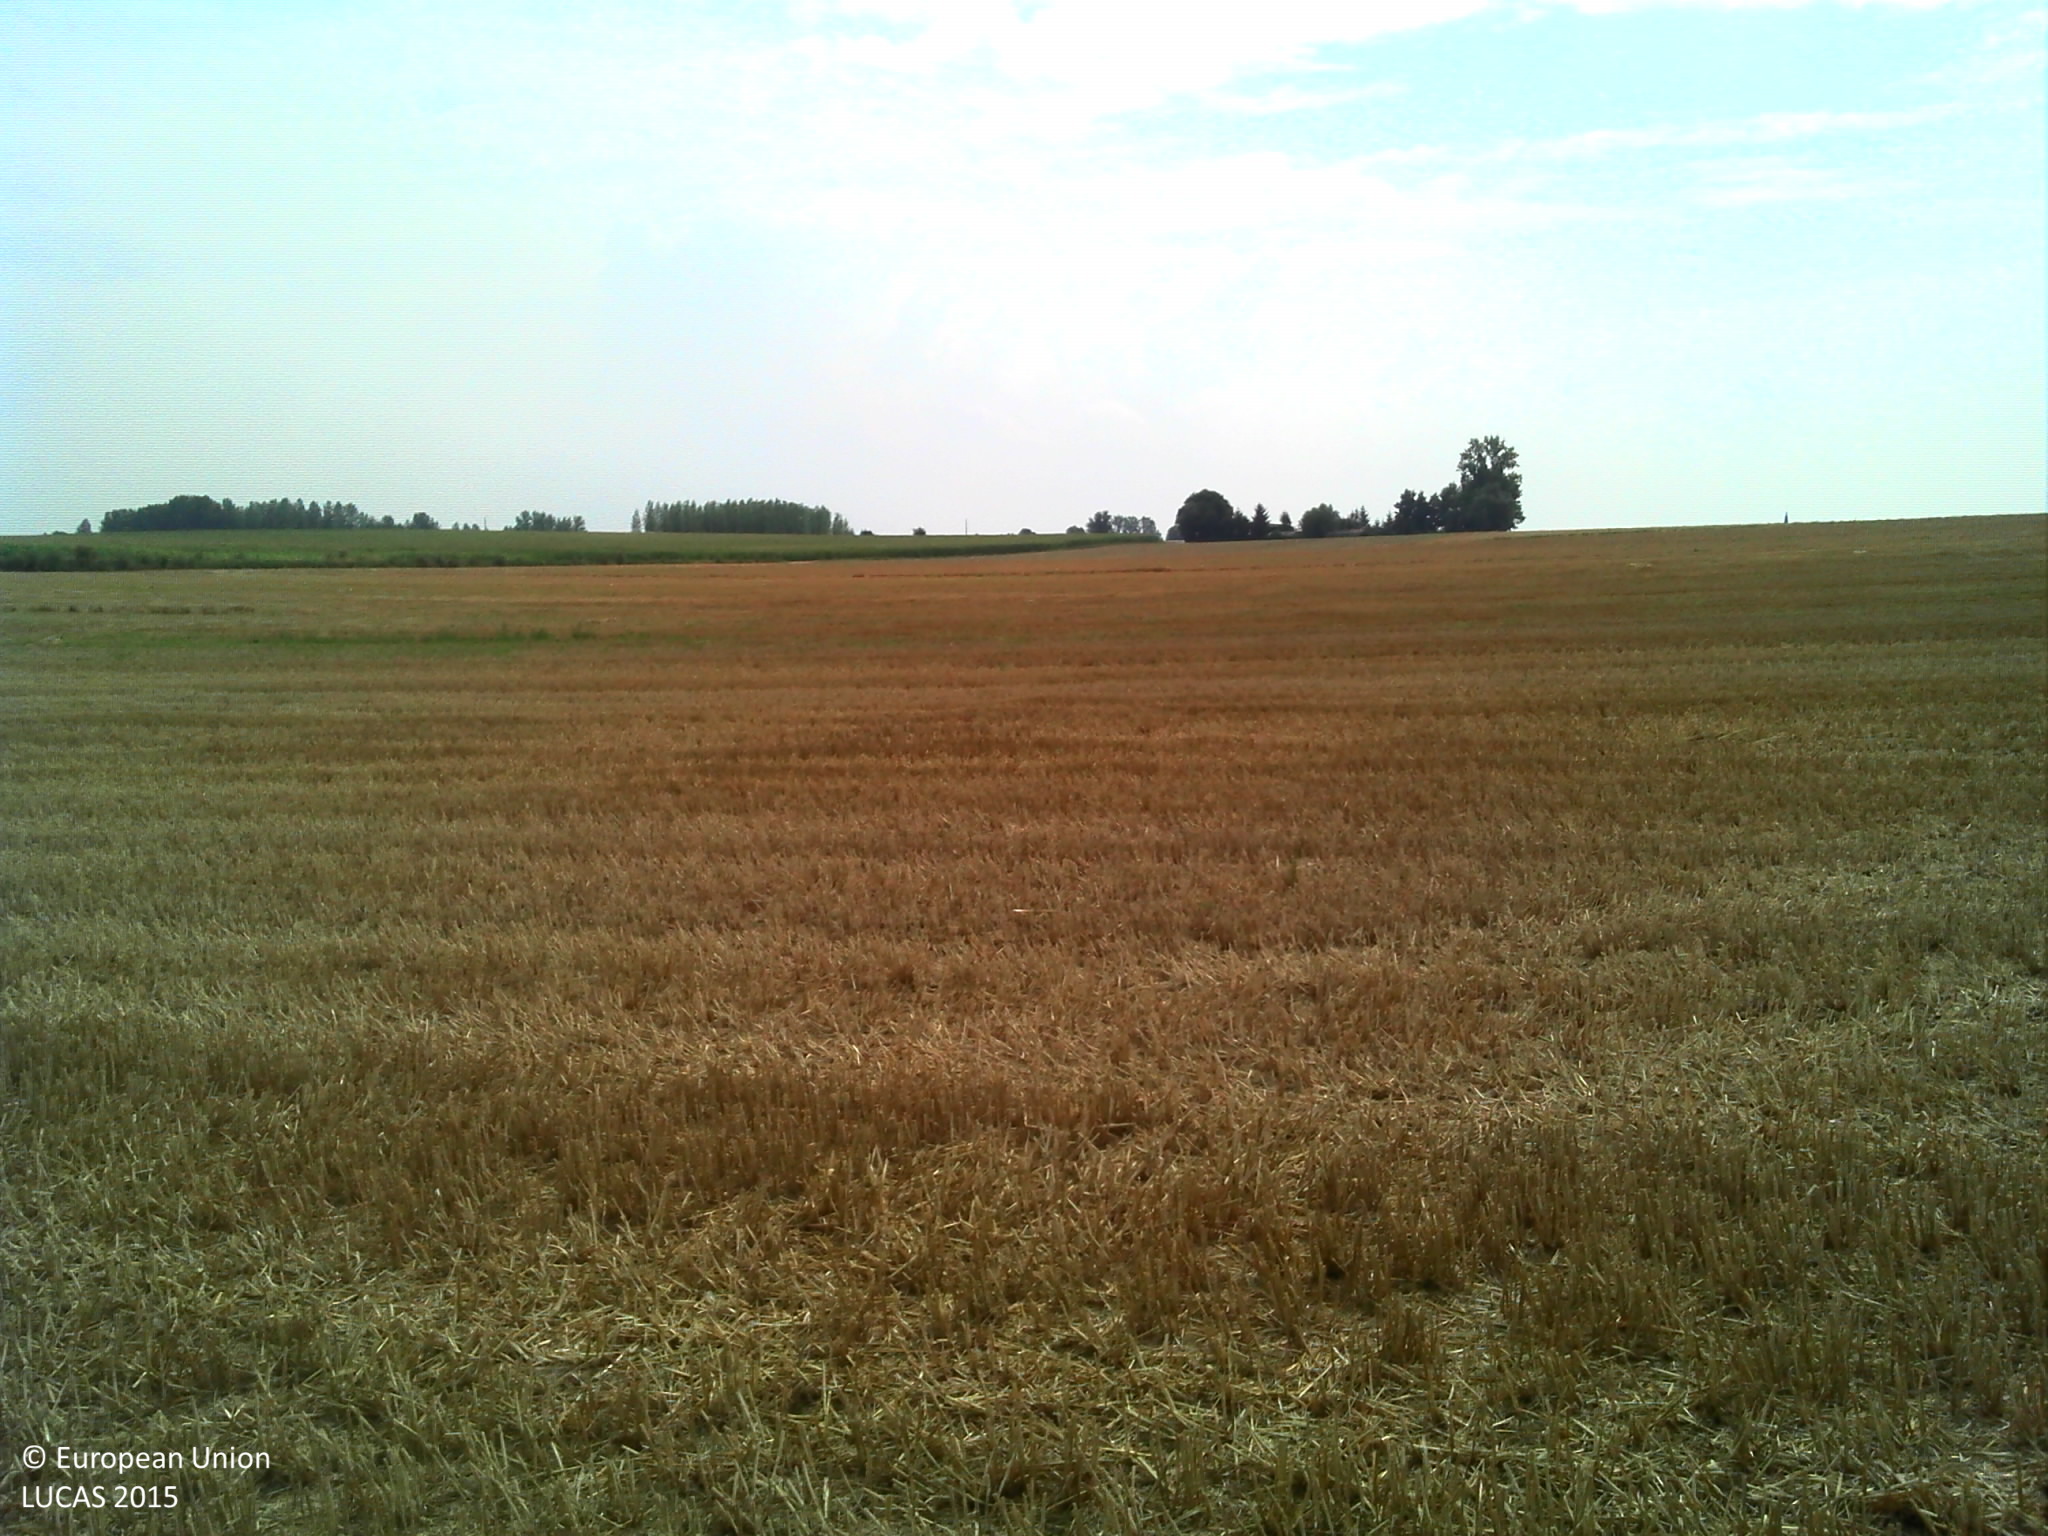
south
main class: Cropland
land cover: Common wheat
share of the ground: 10 - 25 %
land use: Agriculture (excluding fallow land and kitchen gardens)
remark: Harvested field
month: August
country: FR
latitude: 50.2039
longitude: 3.6180
